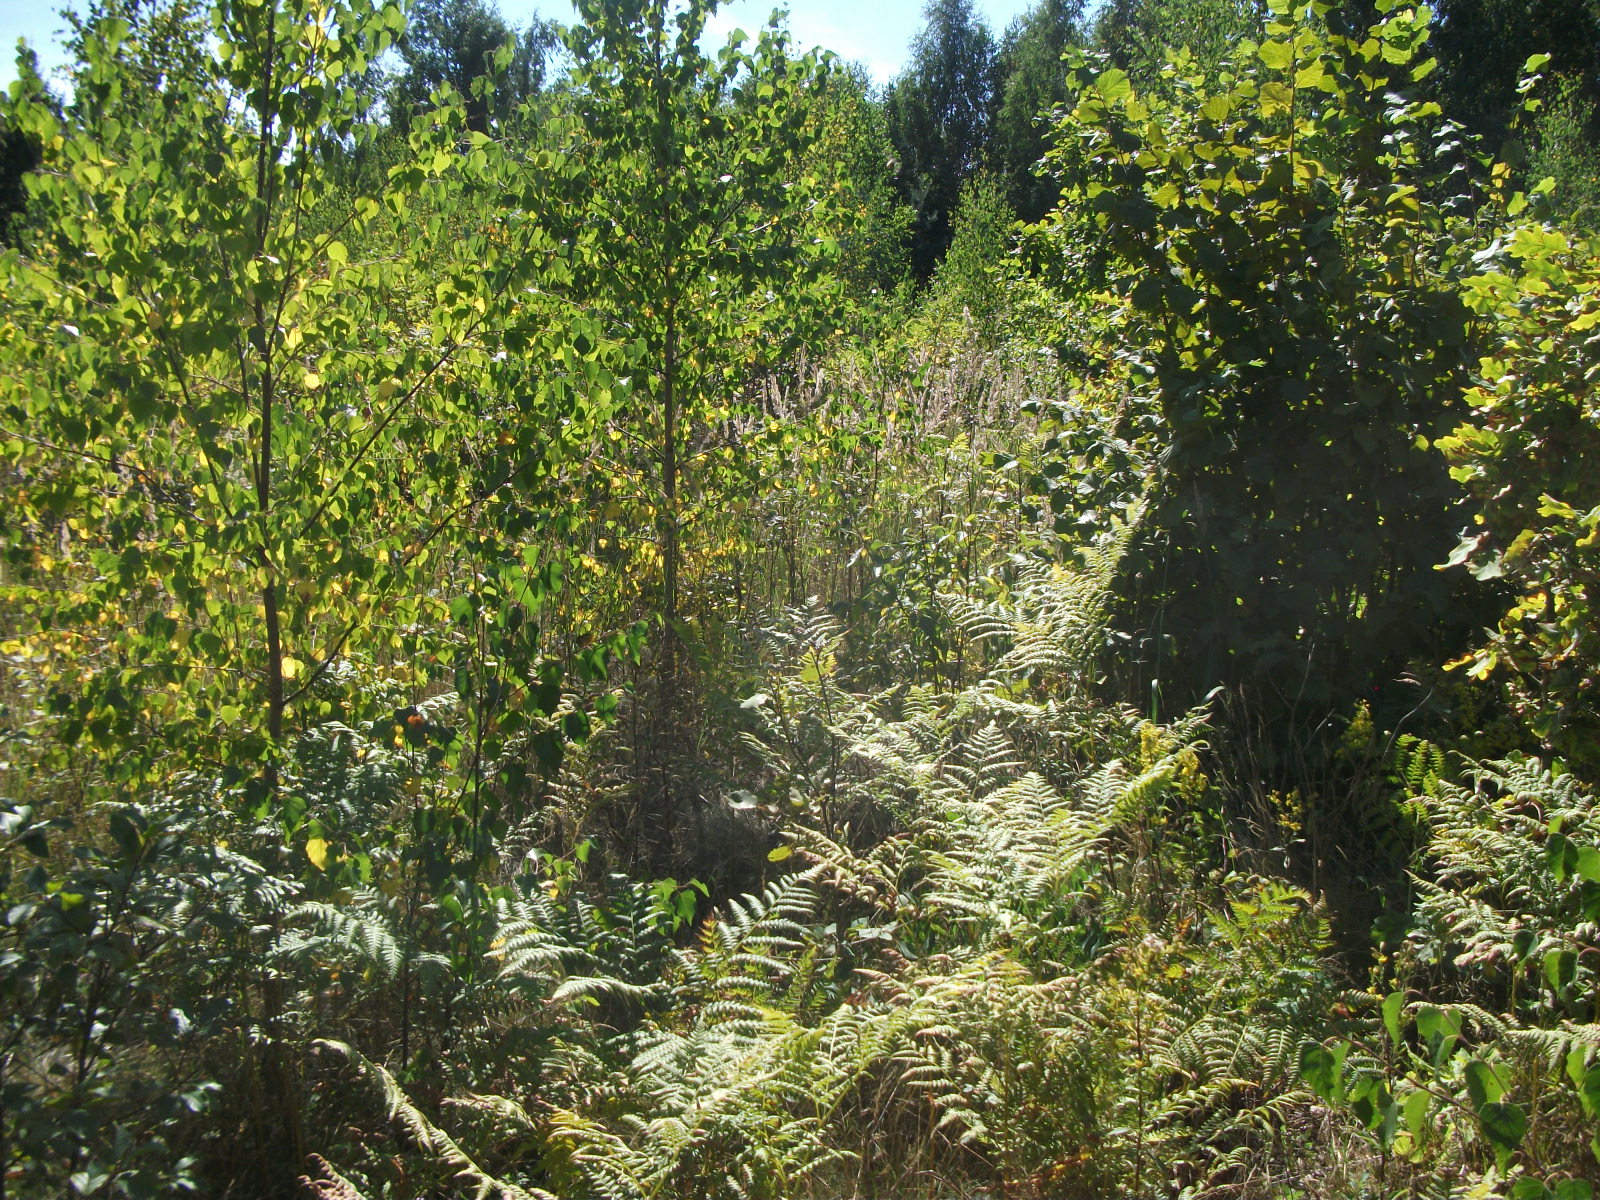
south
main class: Woodland
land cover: Broadleaved woodland
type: non-riverine alder, birch or aspen forest
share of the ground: 50 - 75 %
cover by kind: broadleaved forest trees 50 %, shrubs 30 %, herbaceous plants 15 %, coniferous forest trees 5 %
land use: Forestry
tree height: < 5 m
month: August
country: LV
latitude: 56.4888
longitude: 26.0674
